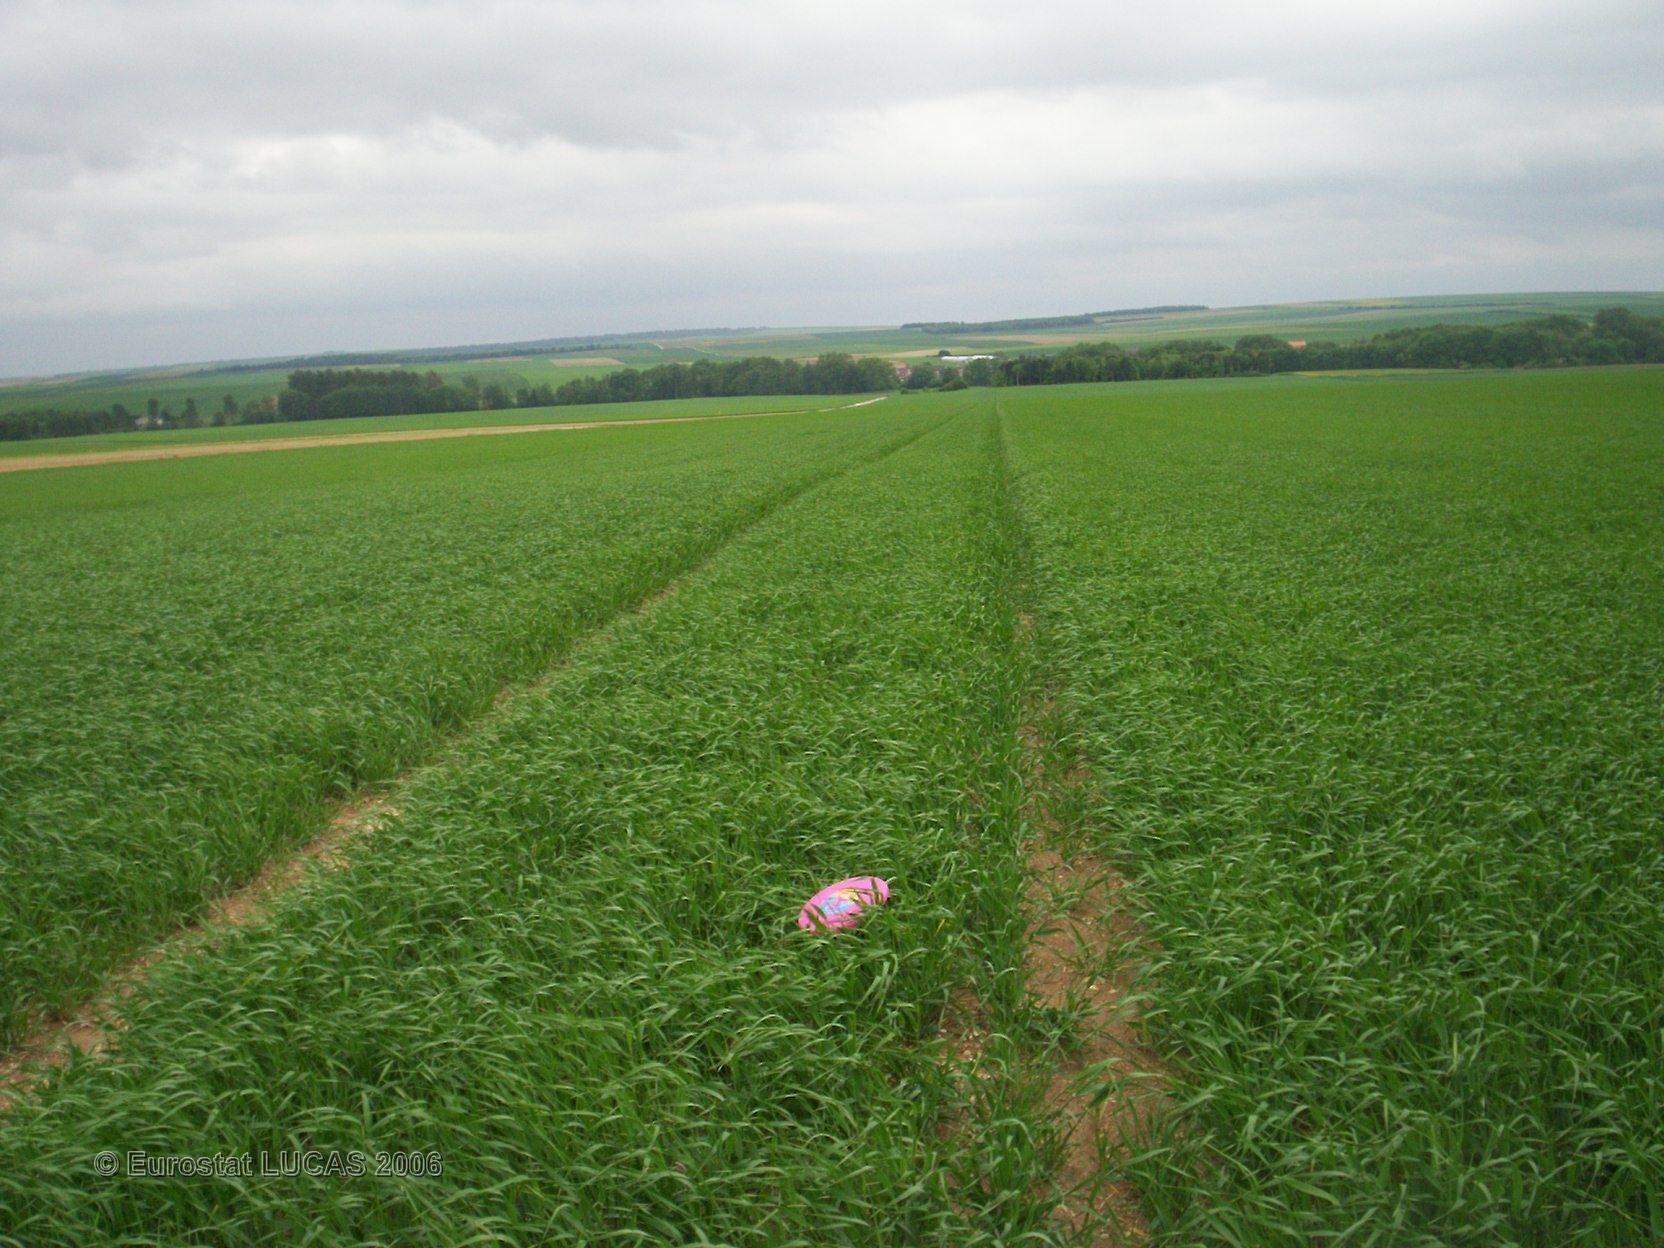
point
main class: Cropland
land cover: Barley
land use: Agriculture (excluding fallow land and kitchen gardens)
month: May
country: FR
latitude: 49.3102
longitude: 4.4531
